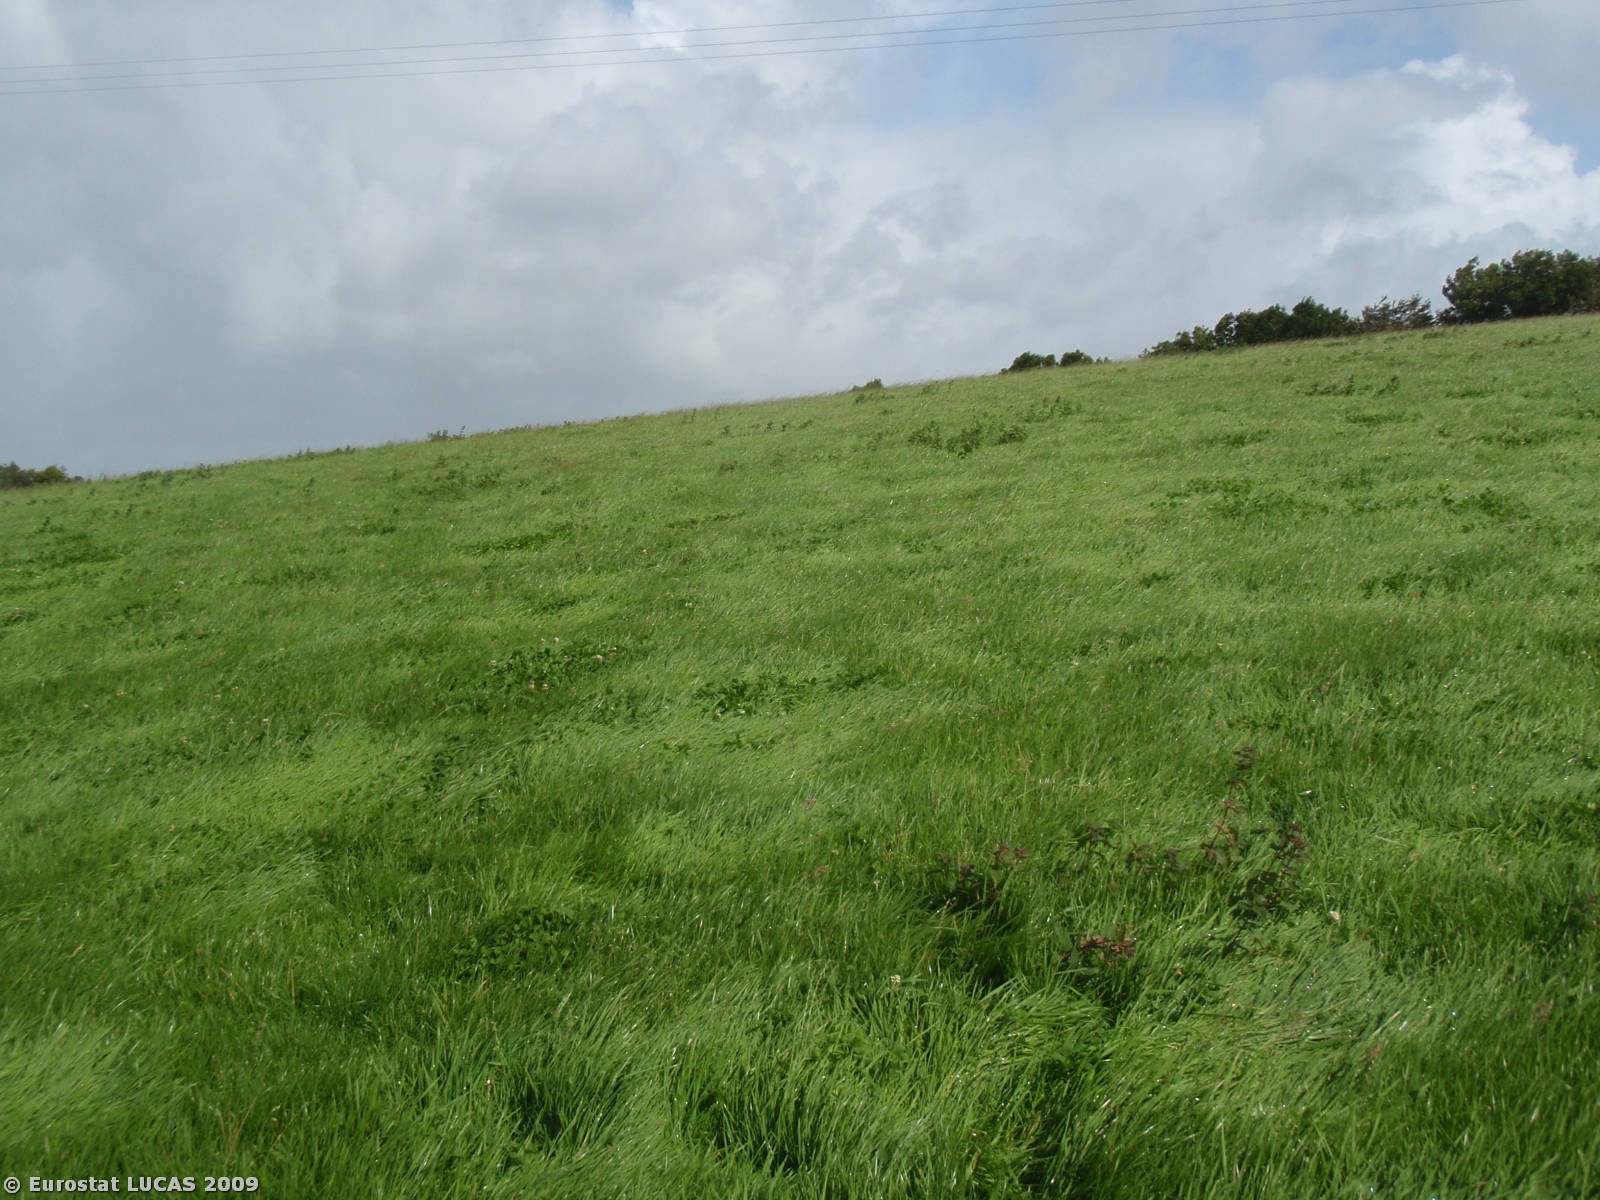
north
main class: Grassland
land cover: Grassland without tree/shrub cover
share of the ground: > 75 %
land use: Agriculture (excluding fallow land and kitchen gardens)
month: August
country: GB
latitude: 51.1415
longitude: -3.5350
